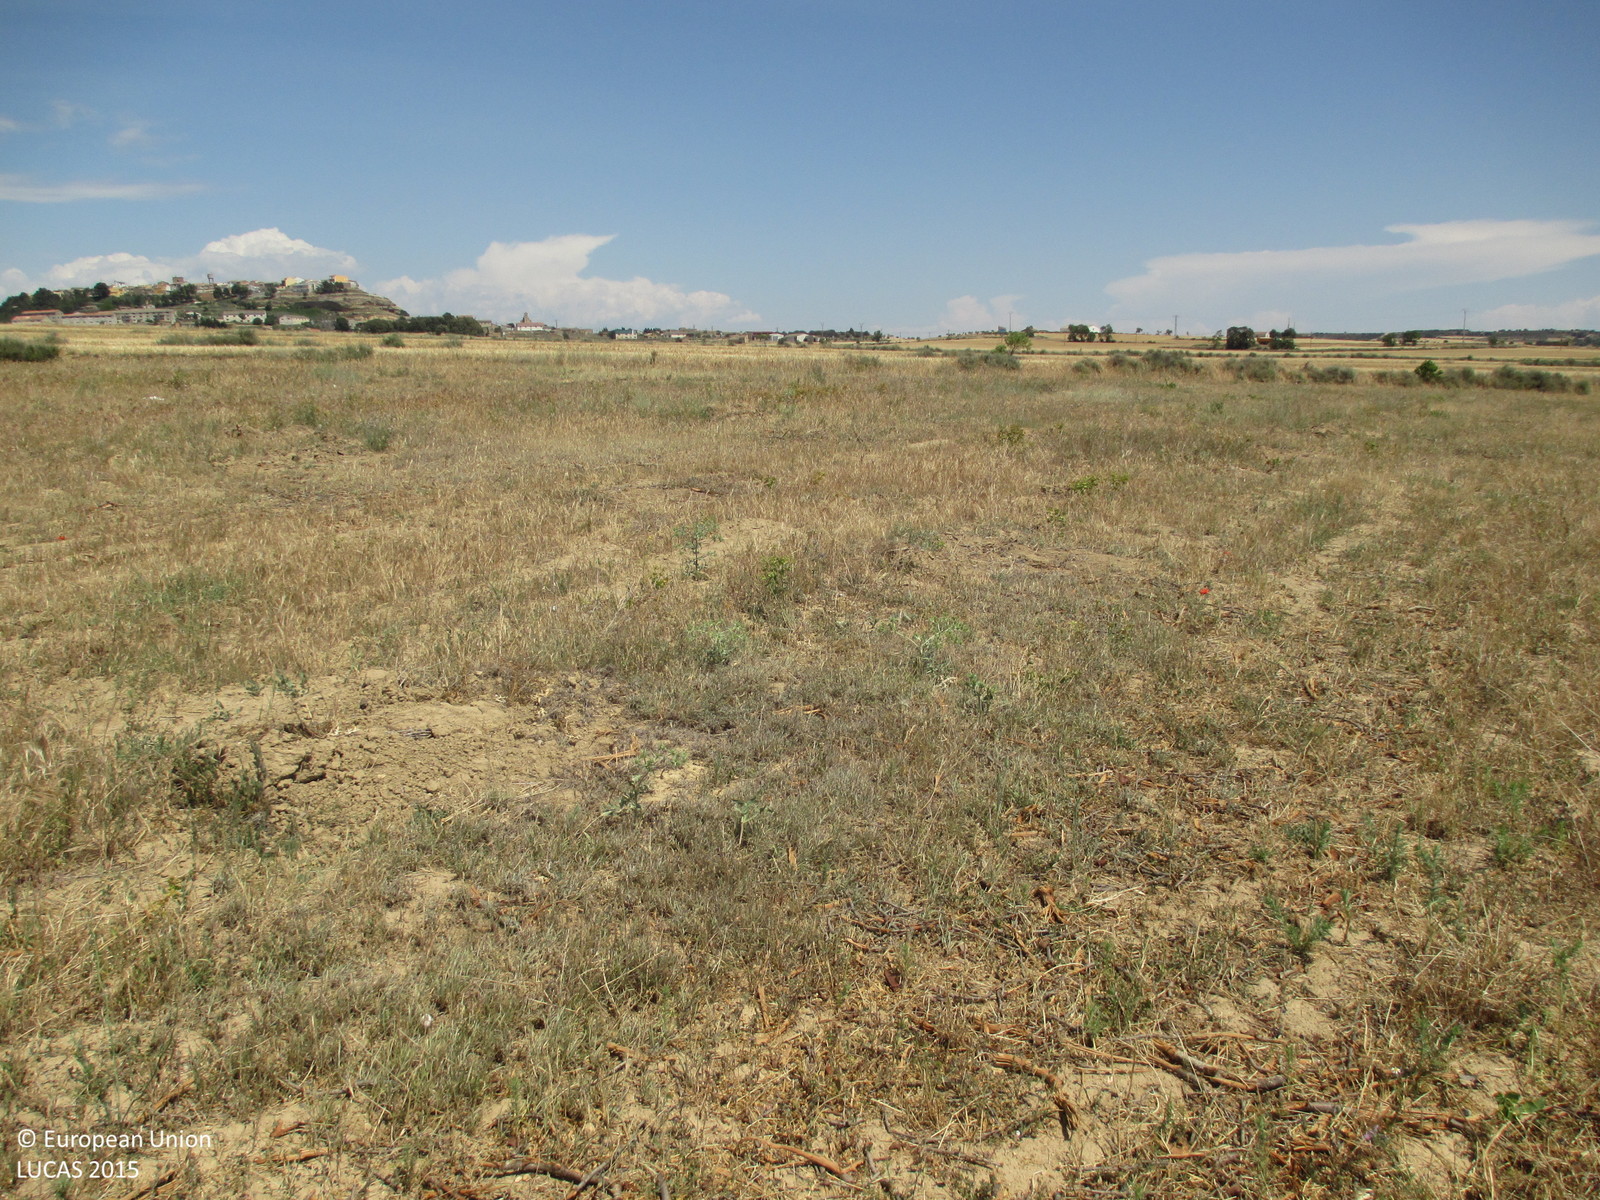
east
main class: Grassland
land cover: Spontaneously vegetated surfaces
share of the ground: 50 - 75 %
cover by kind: herbaceous plants 65 %, unconsolidated bare surface 35 %
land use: Fallow land
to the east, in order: Spontaneously vegetated surfaces; Barley; Shruby margins; Barley; Shruby margins; Barley; Shruby margins; Barley; Shruby margins; Barley
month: May
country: ES
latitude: 41.9559
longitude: -0.0199
